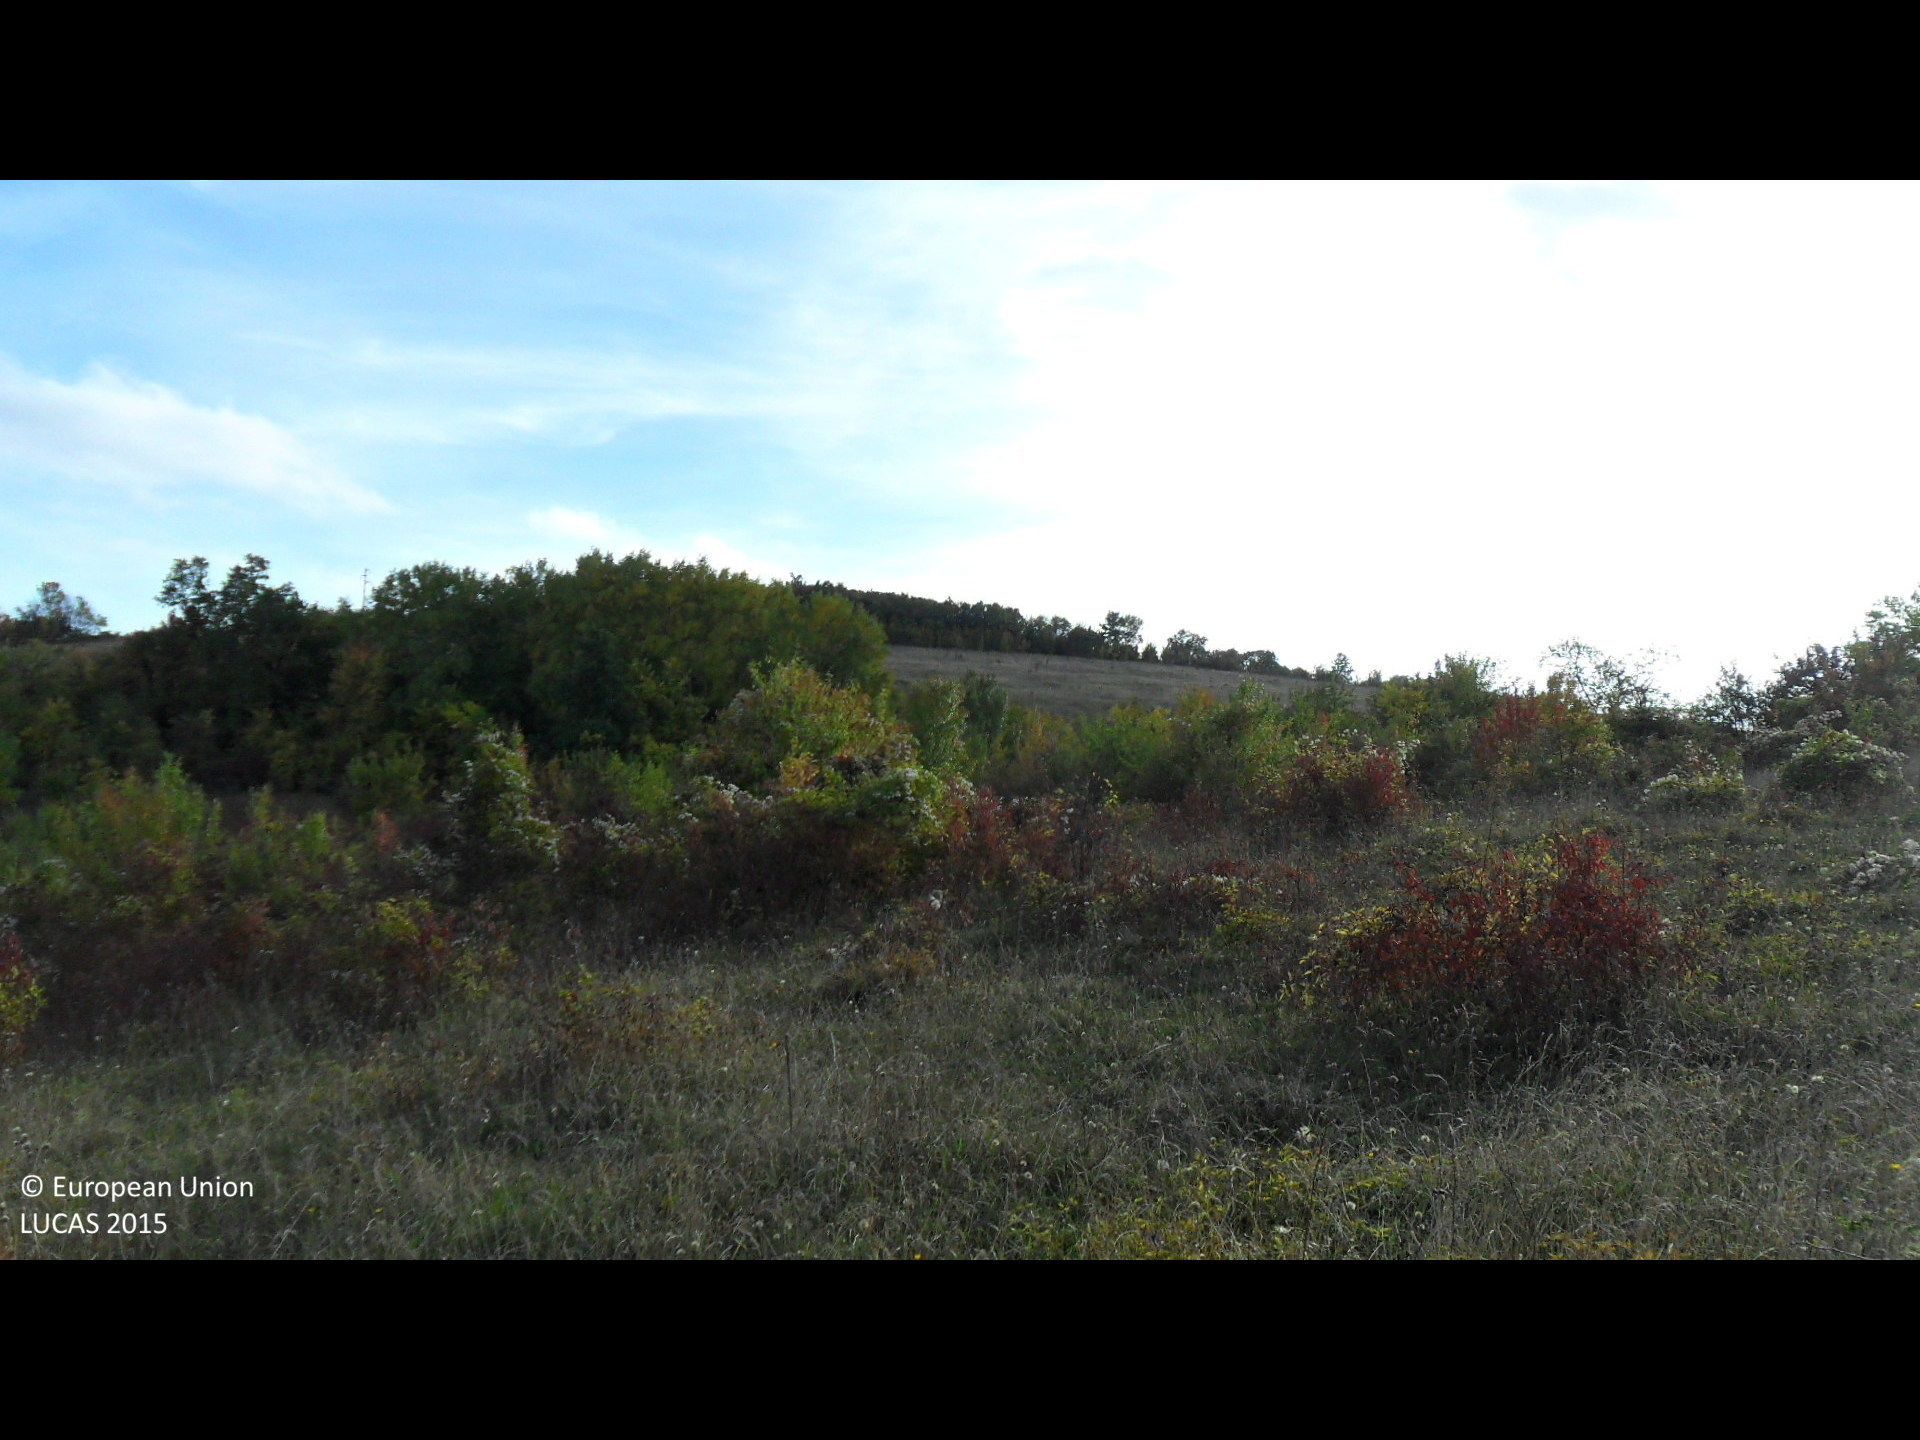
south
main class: Grassland
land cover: Grassland with sparse tree/shrub cover
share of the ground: > 75 %
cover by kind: herbaceous plants 90 %, broadleaved forest trees 5 %, shrubs 5 %
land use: Agriculture (excluding fallow land and kitchen gardens)
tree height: < 5 m
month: October
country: BG
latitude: 43.0725
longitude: 26.1677
